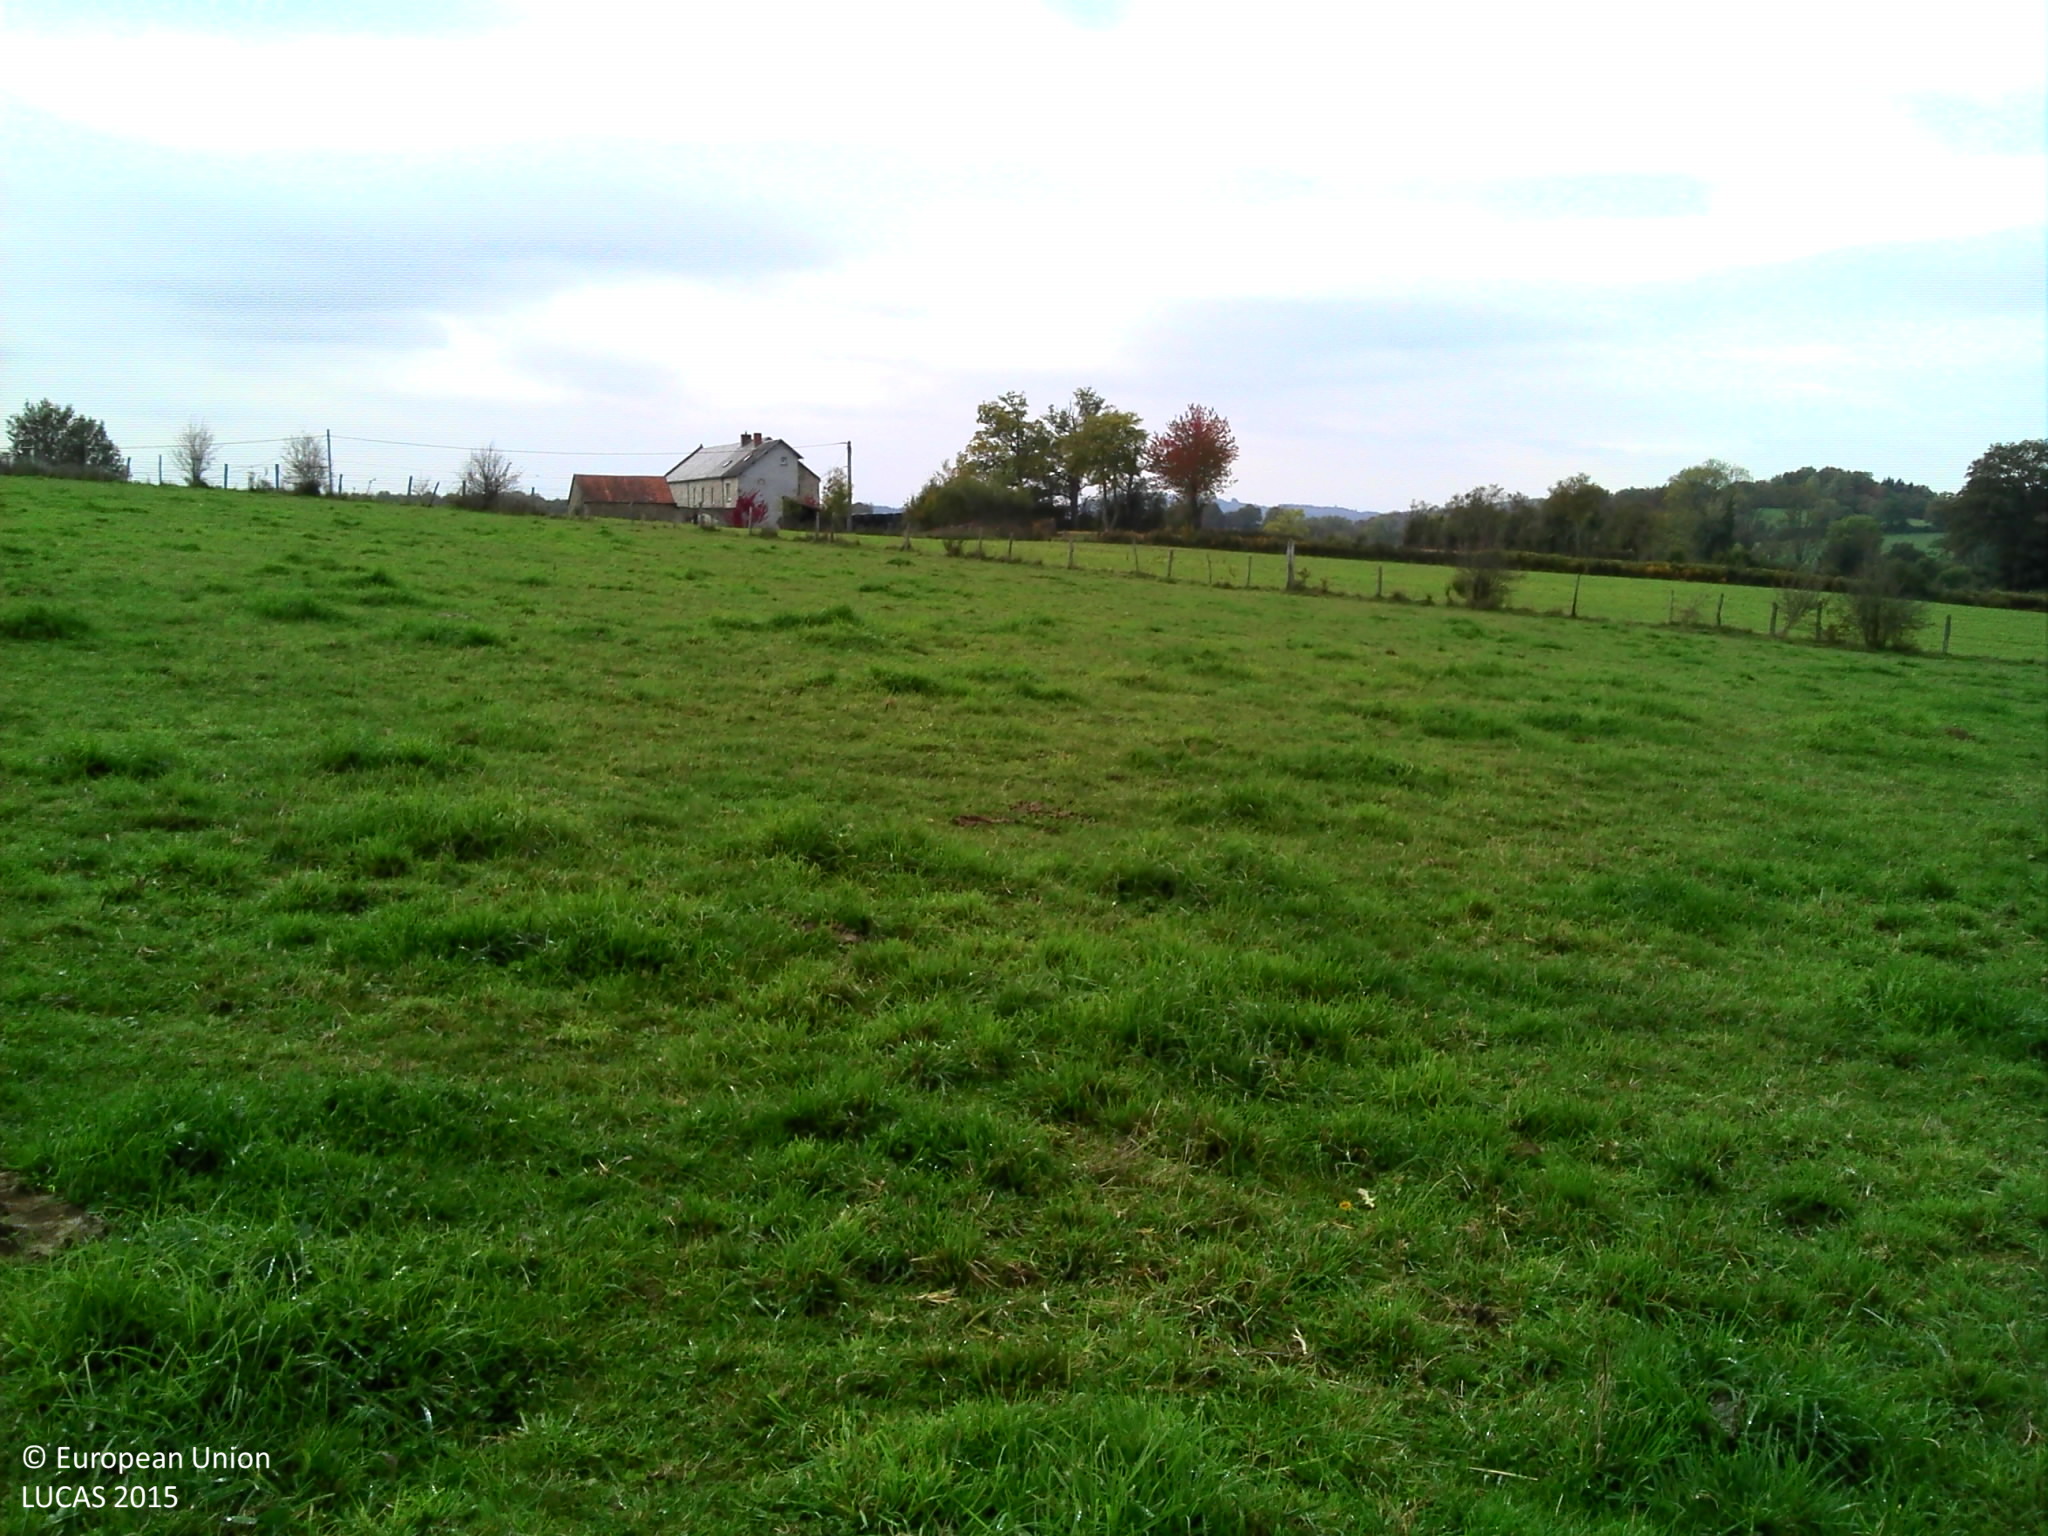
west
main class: Grassland
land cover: Grassland without tree/shrub cover
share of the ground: > 75 %
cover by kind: herbaceous plants 100 %
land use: Agriculture (excluding fallow land and kitchen gardens)
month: October
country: FR
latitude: 46.0737
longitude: 2.8218
